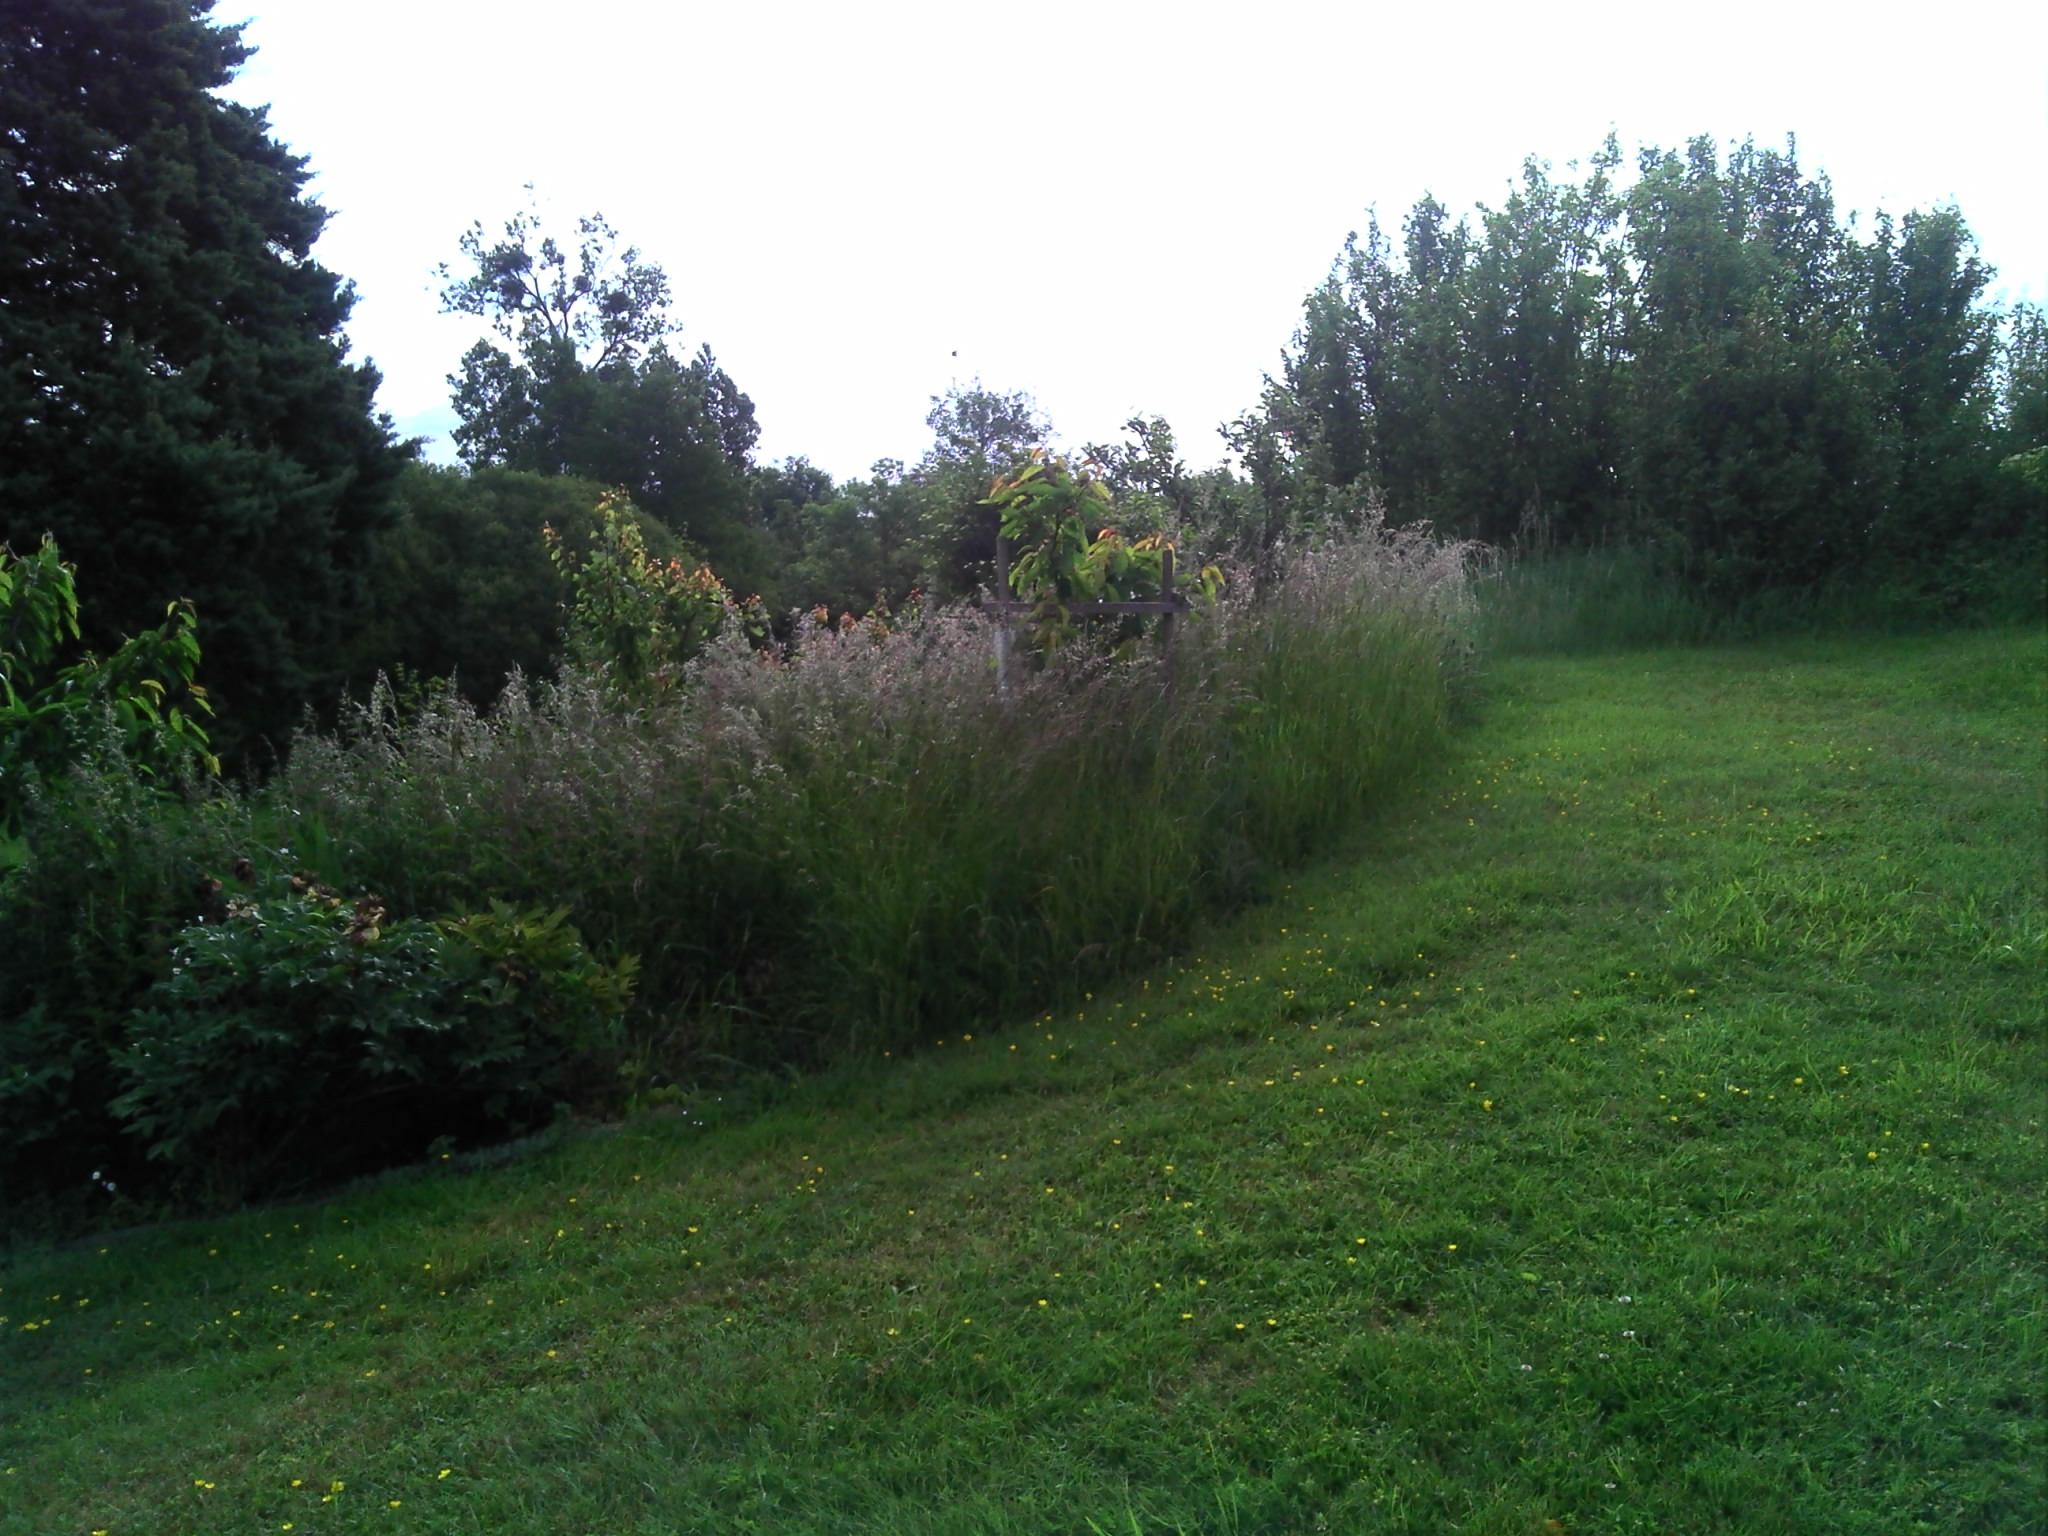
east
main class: Grassland
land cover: Grassland with sparse tree/shrub cover
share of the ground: > 75 %
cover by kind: herbaceous plants 90 %, broadleaved forest trees 5 %, shrubs 5 %
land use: Residential
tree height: < 5 m
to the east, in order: Grassland with sparse tree/shrub cover; Lines of trees; Grassland with sparse tree/shrub cover; Broadleaved woodland; Grassland with sparse tree/shrub cover
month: June
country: FR
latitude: 47.9730
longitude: 1.3433
